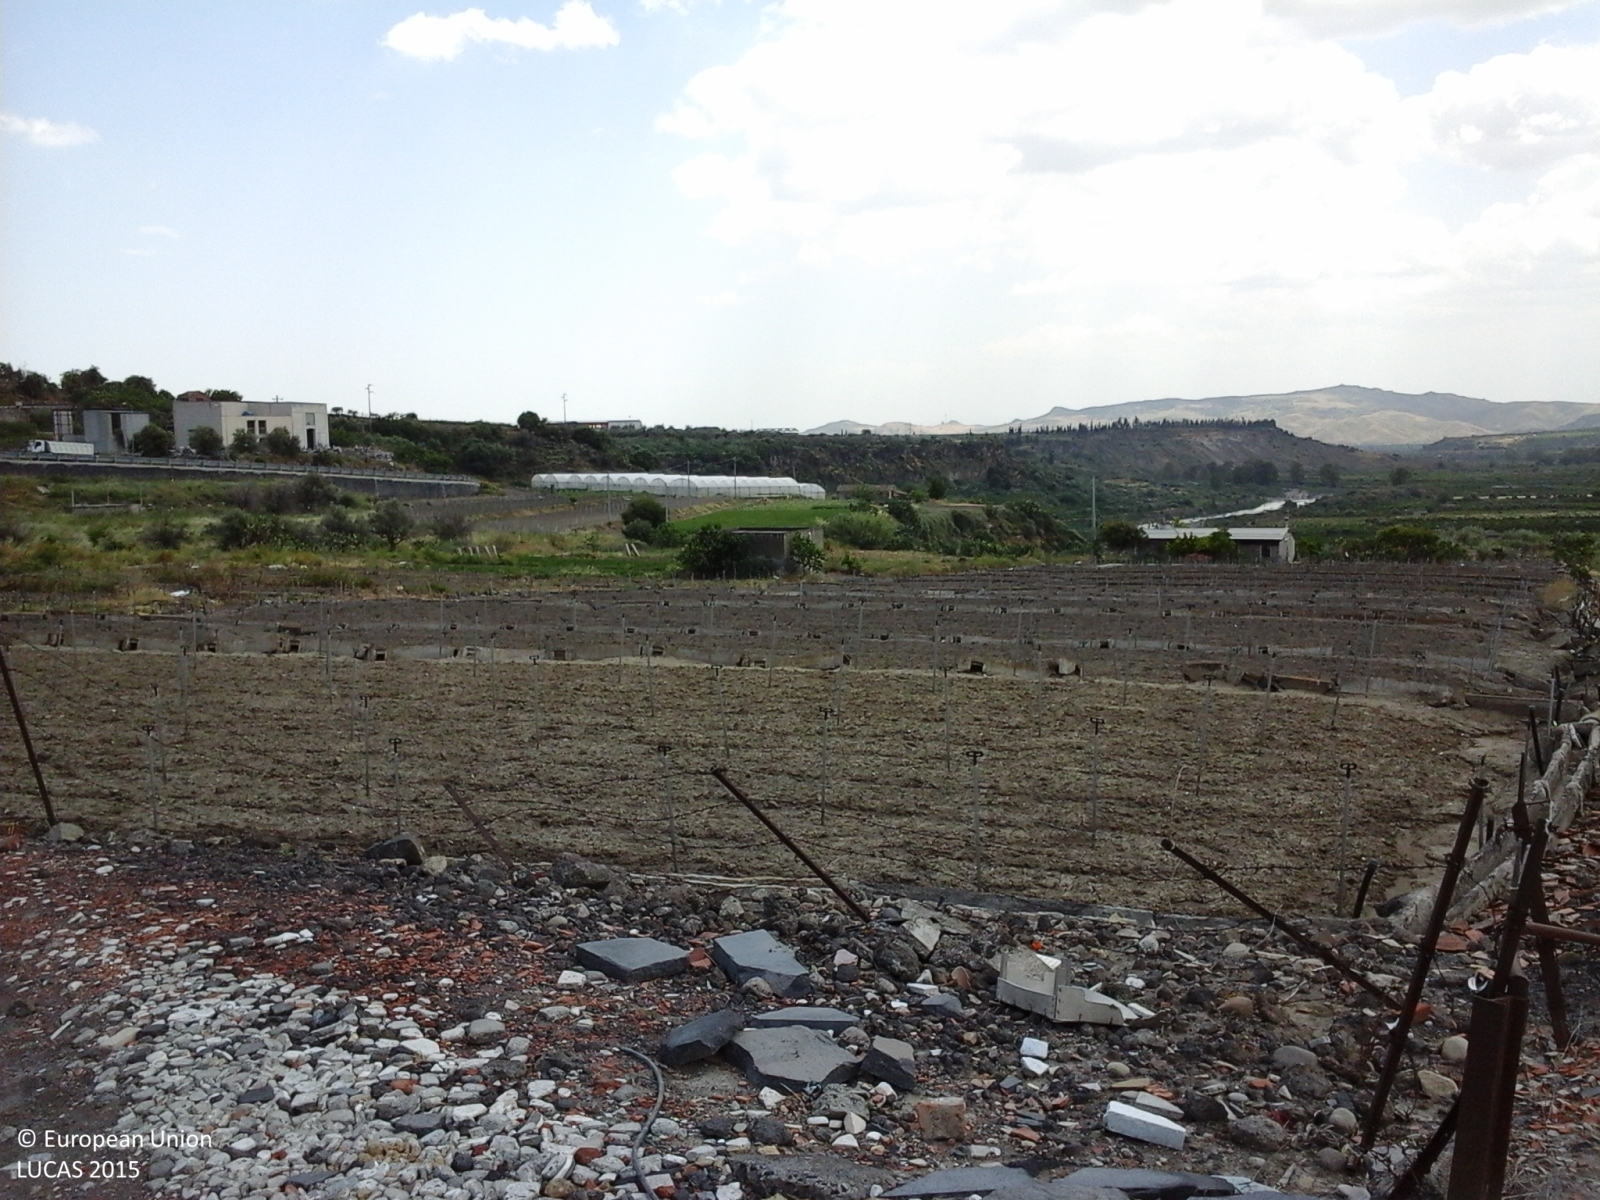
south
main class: Grassland
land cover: Grassland without tree/shrub cover
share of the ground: > 75 %
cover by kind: herbaceous plants 100 %
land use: Agriculture (excluding fallow land and kitchen gardens)
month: May
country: IT
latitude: 37.6431
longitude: 14.8277
